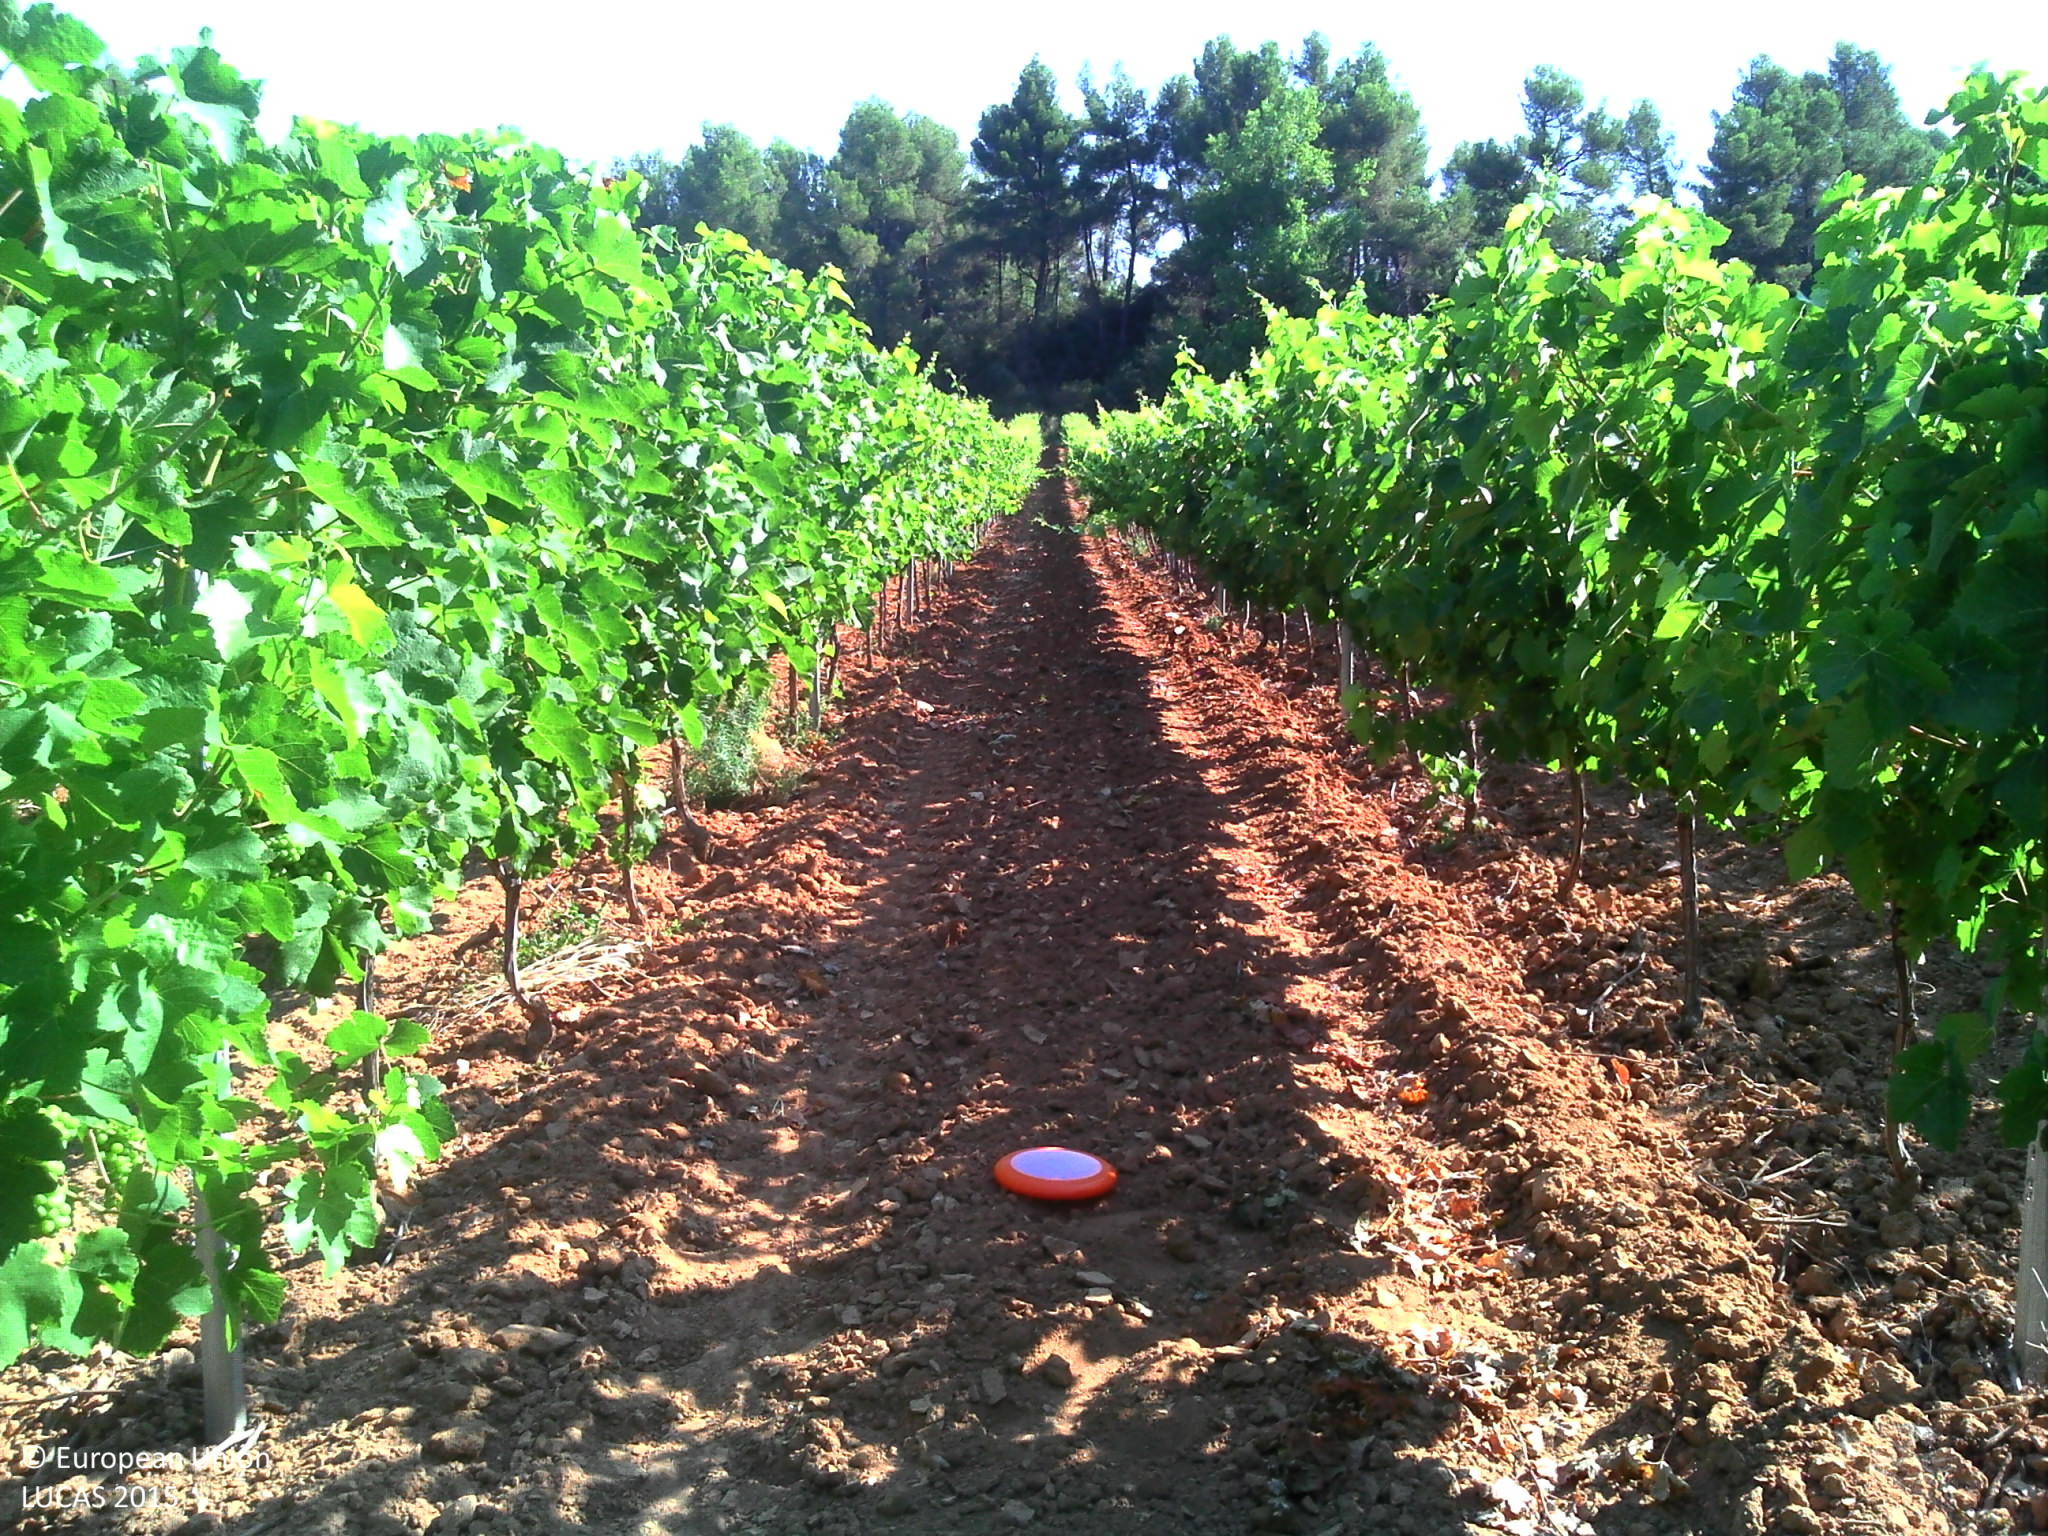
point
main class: Cropland
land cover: Vineyards
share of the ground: 25 - 50 %
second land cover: Other bare soil
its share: > 75 %
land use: Agriculture (excluding fallow land and kitchen gardens)
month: July
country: FR
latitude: 43.4695
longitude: 5.7696
